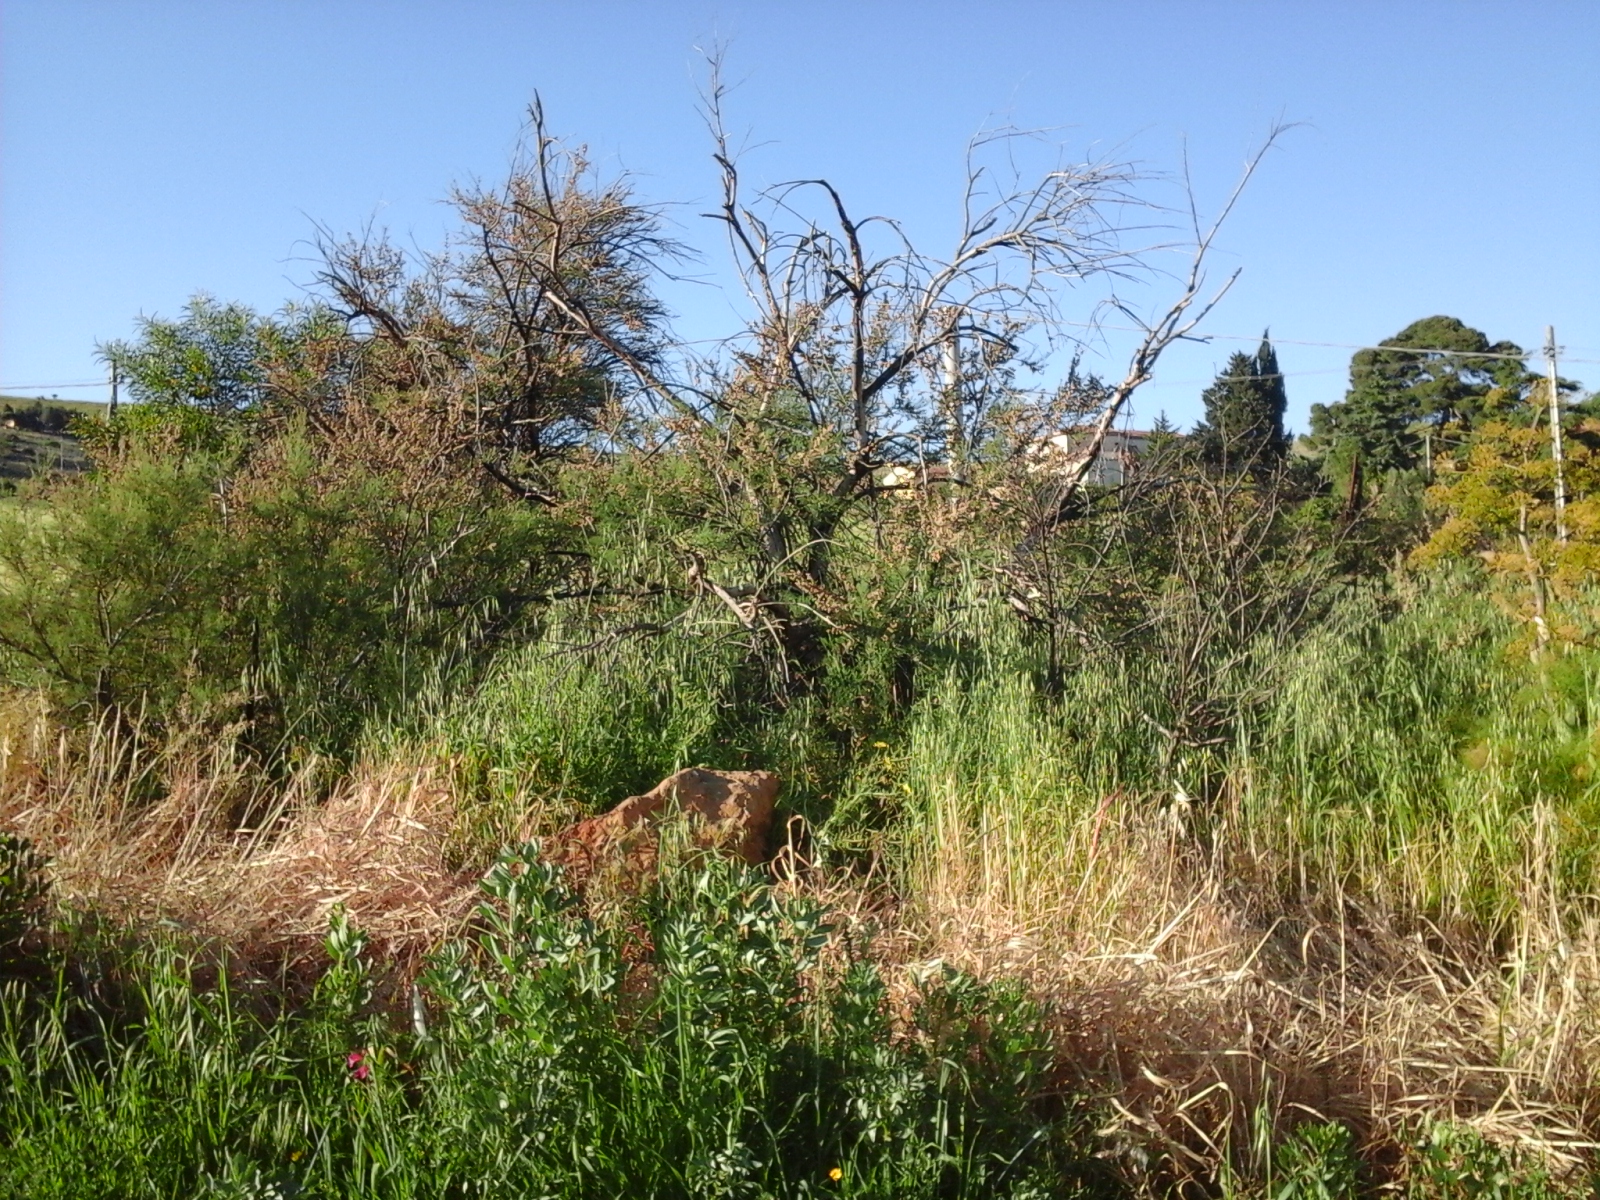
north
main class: Cropland
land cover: Dry pulses
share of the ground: > 75 %
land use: Agriculture (excluding fallow land and kitchen gardens)
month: May
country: IT
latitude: 37.4947
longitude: 14.1203
